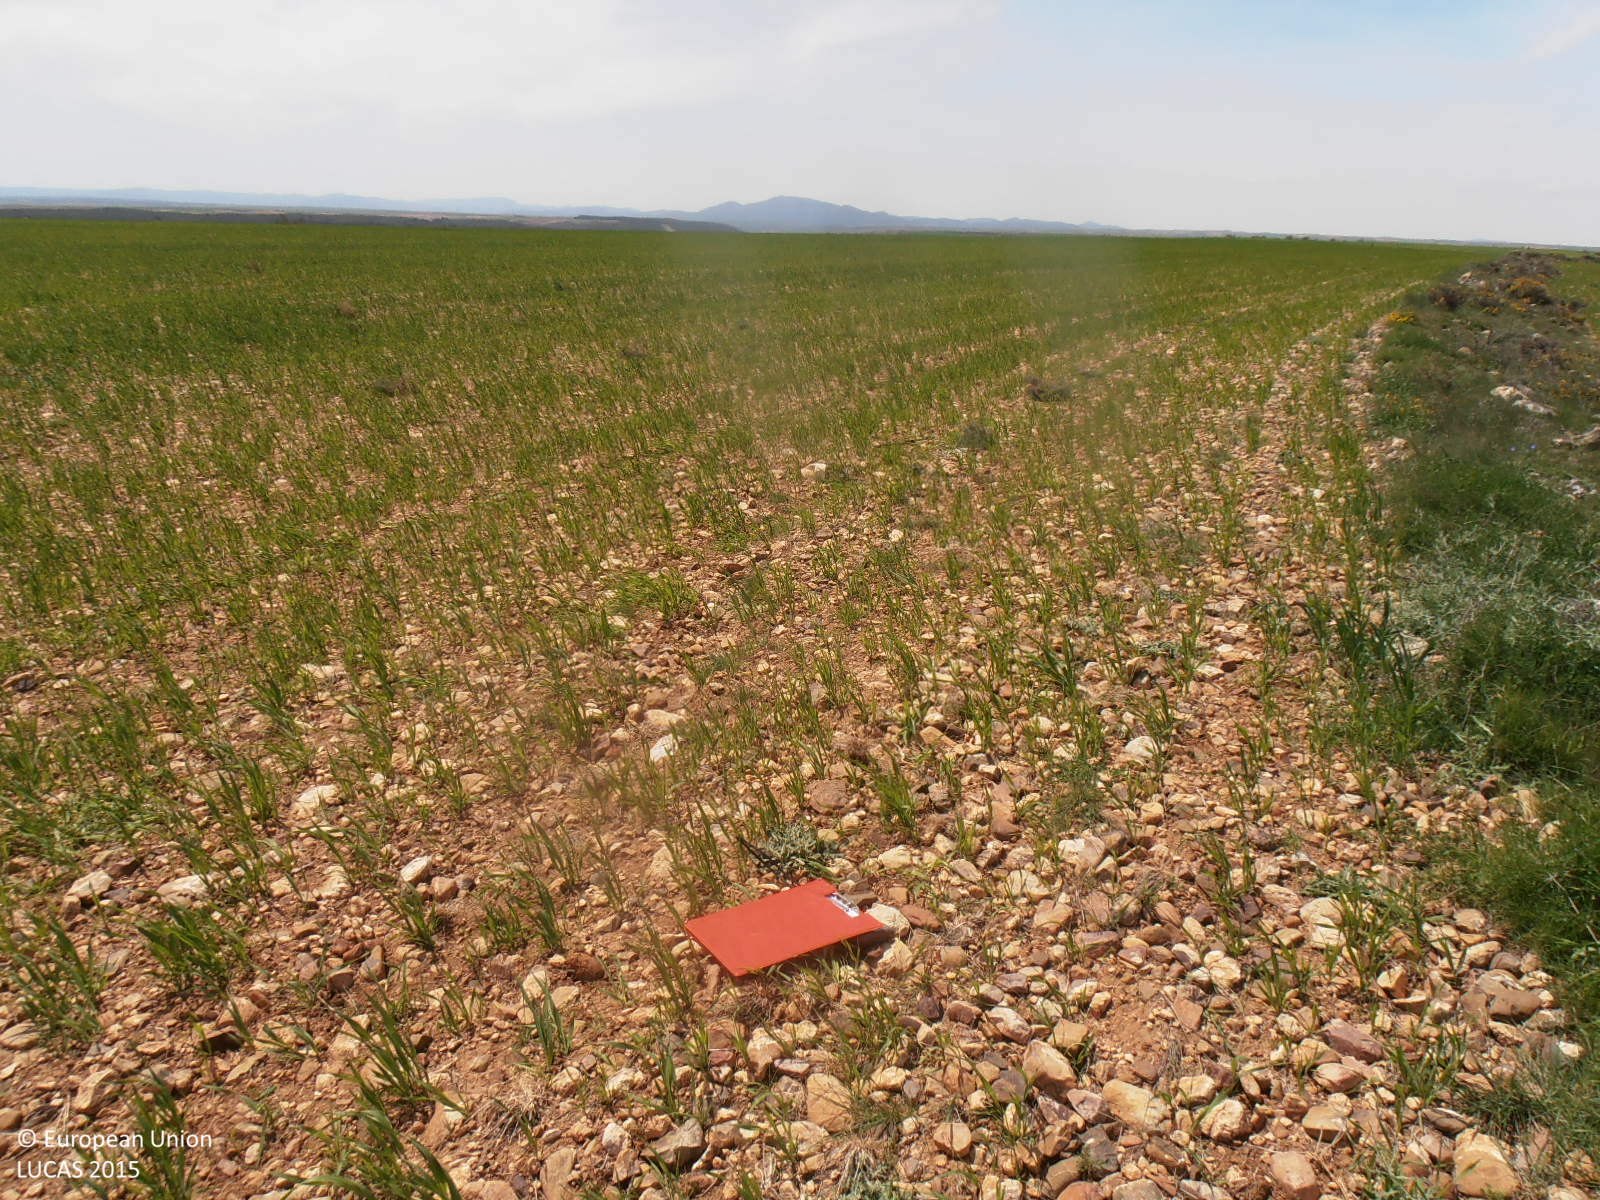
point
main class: Cropland
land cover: Oats
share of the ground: > 75 %
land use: Agriculture (excluding fallow land and kitchen gardens)
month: April
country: ES
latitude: 41.2608
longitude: -0.9157
